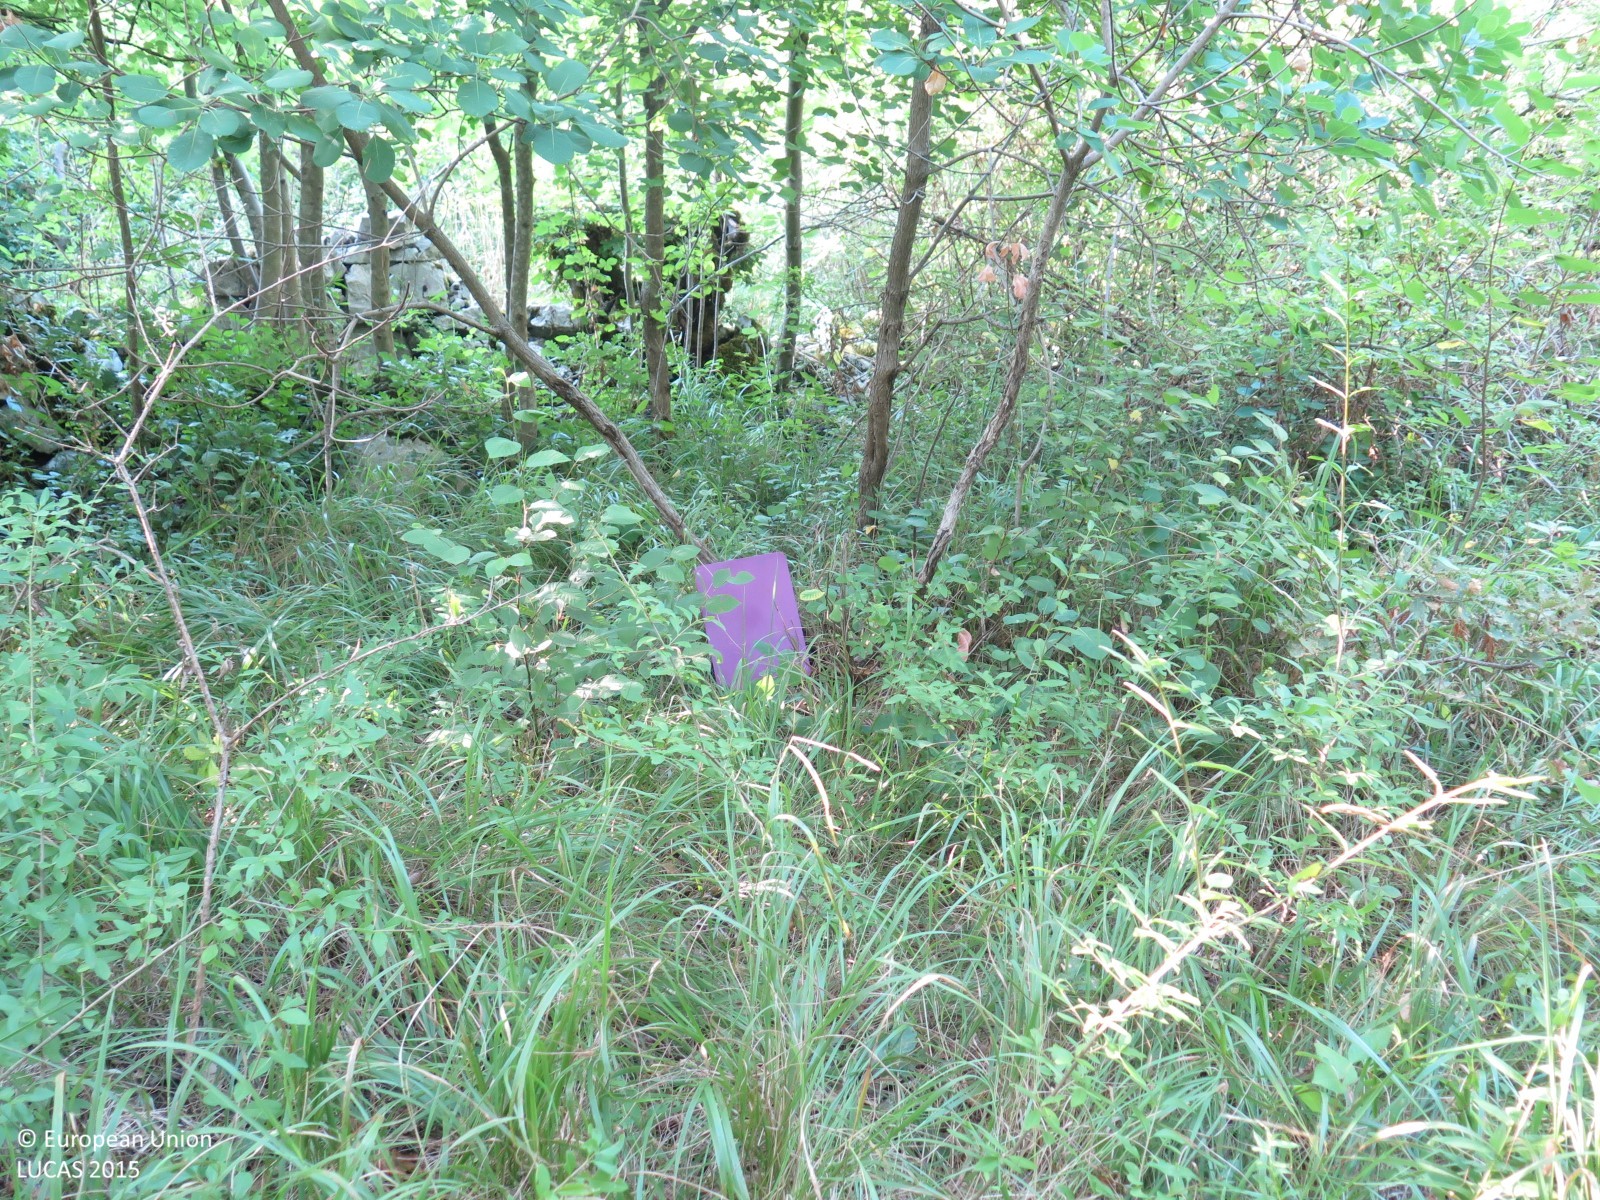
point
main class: Woodland
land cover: Broadleaved woodland
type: acidophilous oak and oak-birch forest
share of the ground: > 75 %
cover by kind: broadleaved forest trees 90 %, shrubs 5 %, herbaceous plants 5 %
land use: Semi-natural and natural areas not in use
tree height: > 5 m
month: July
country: HR
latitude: 45.3719
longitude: 14.0683
